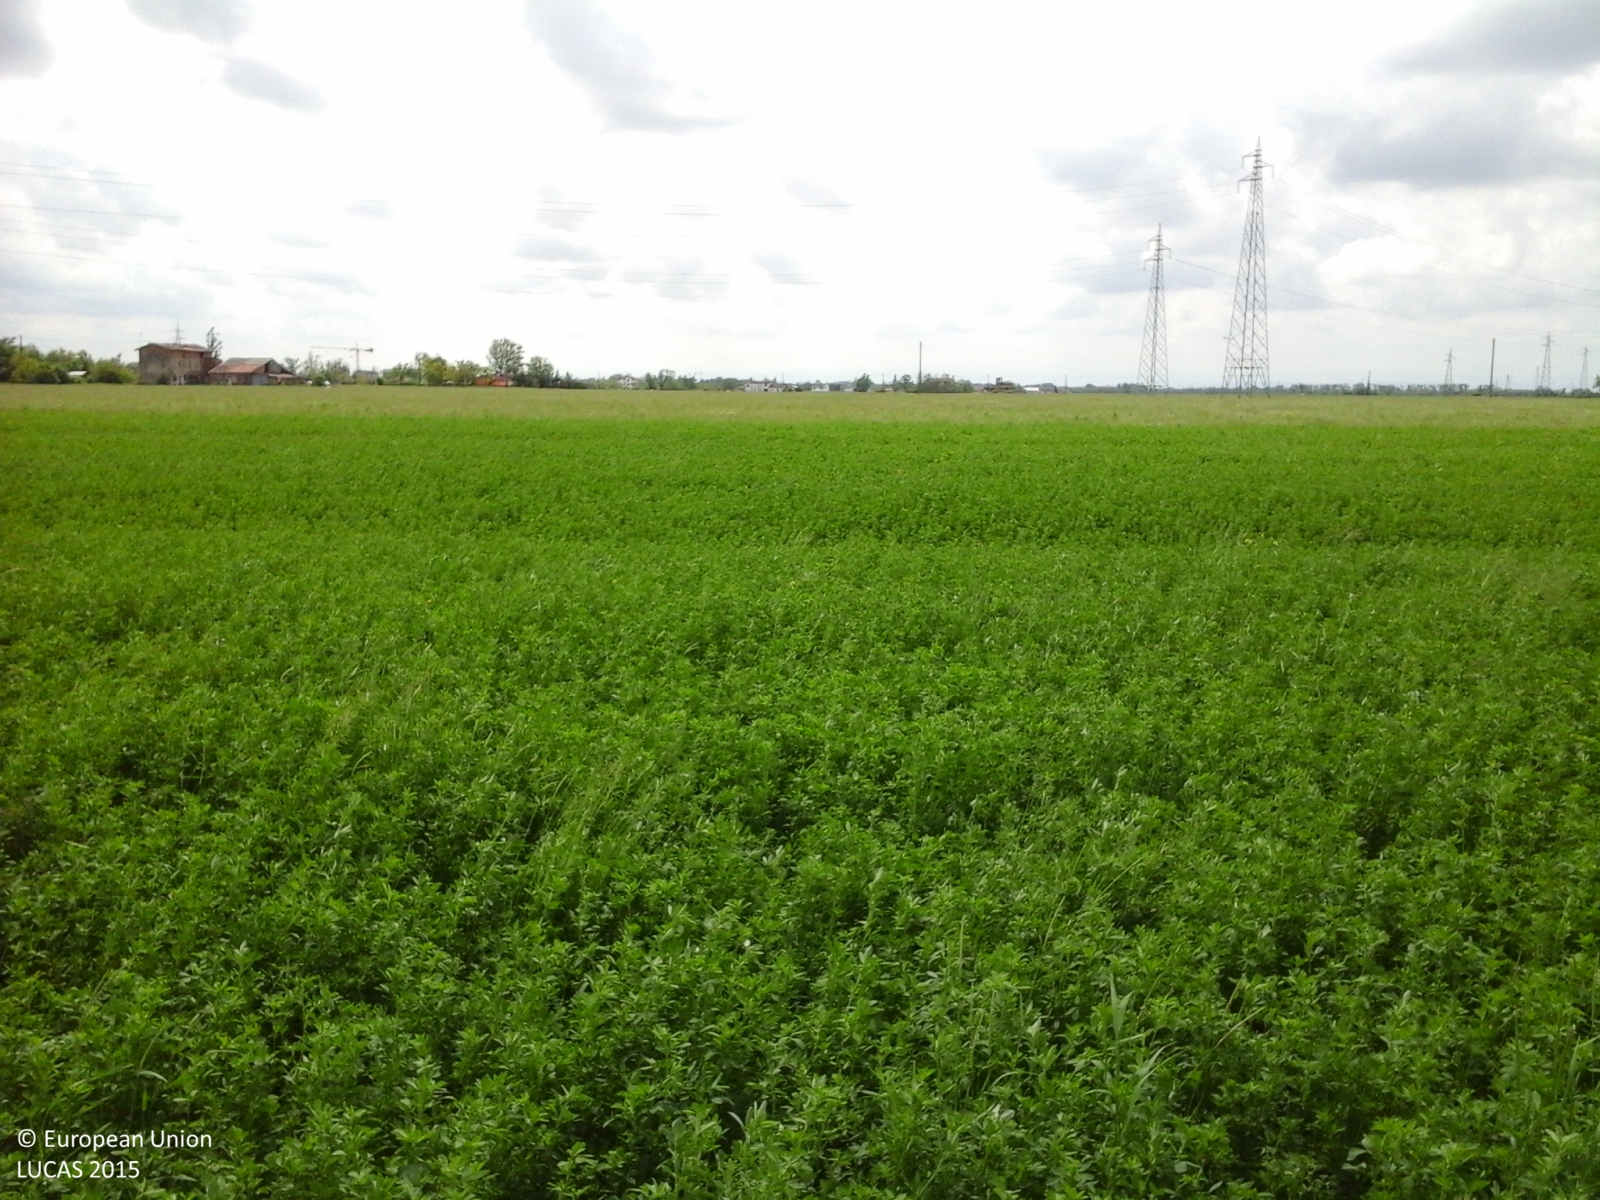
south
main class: Cropland
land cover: Lucerne
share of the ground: > 75 %
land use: Agriculture (excluding fallow land and kitchen gardens)
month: April
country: IT
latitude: 44.8516
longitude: 10.8966
